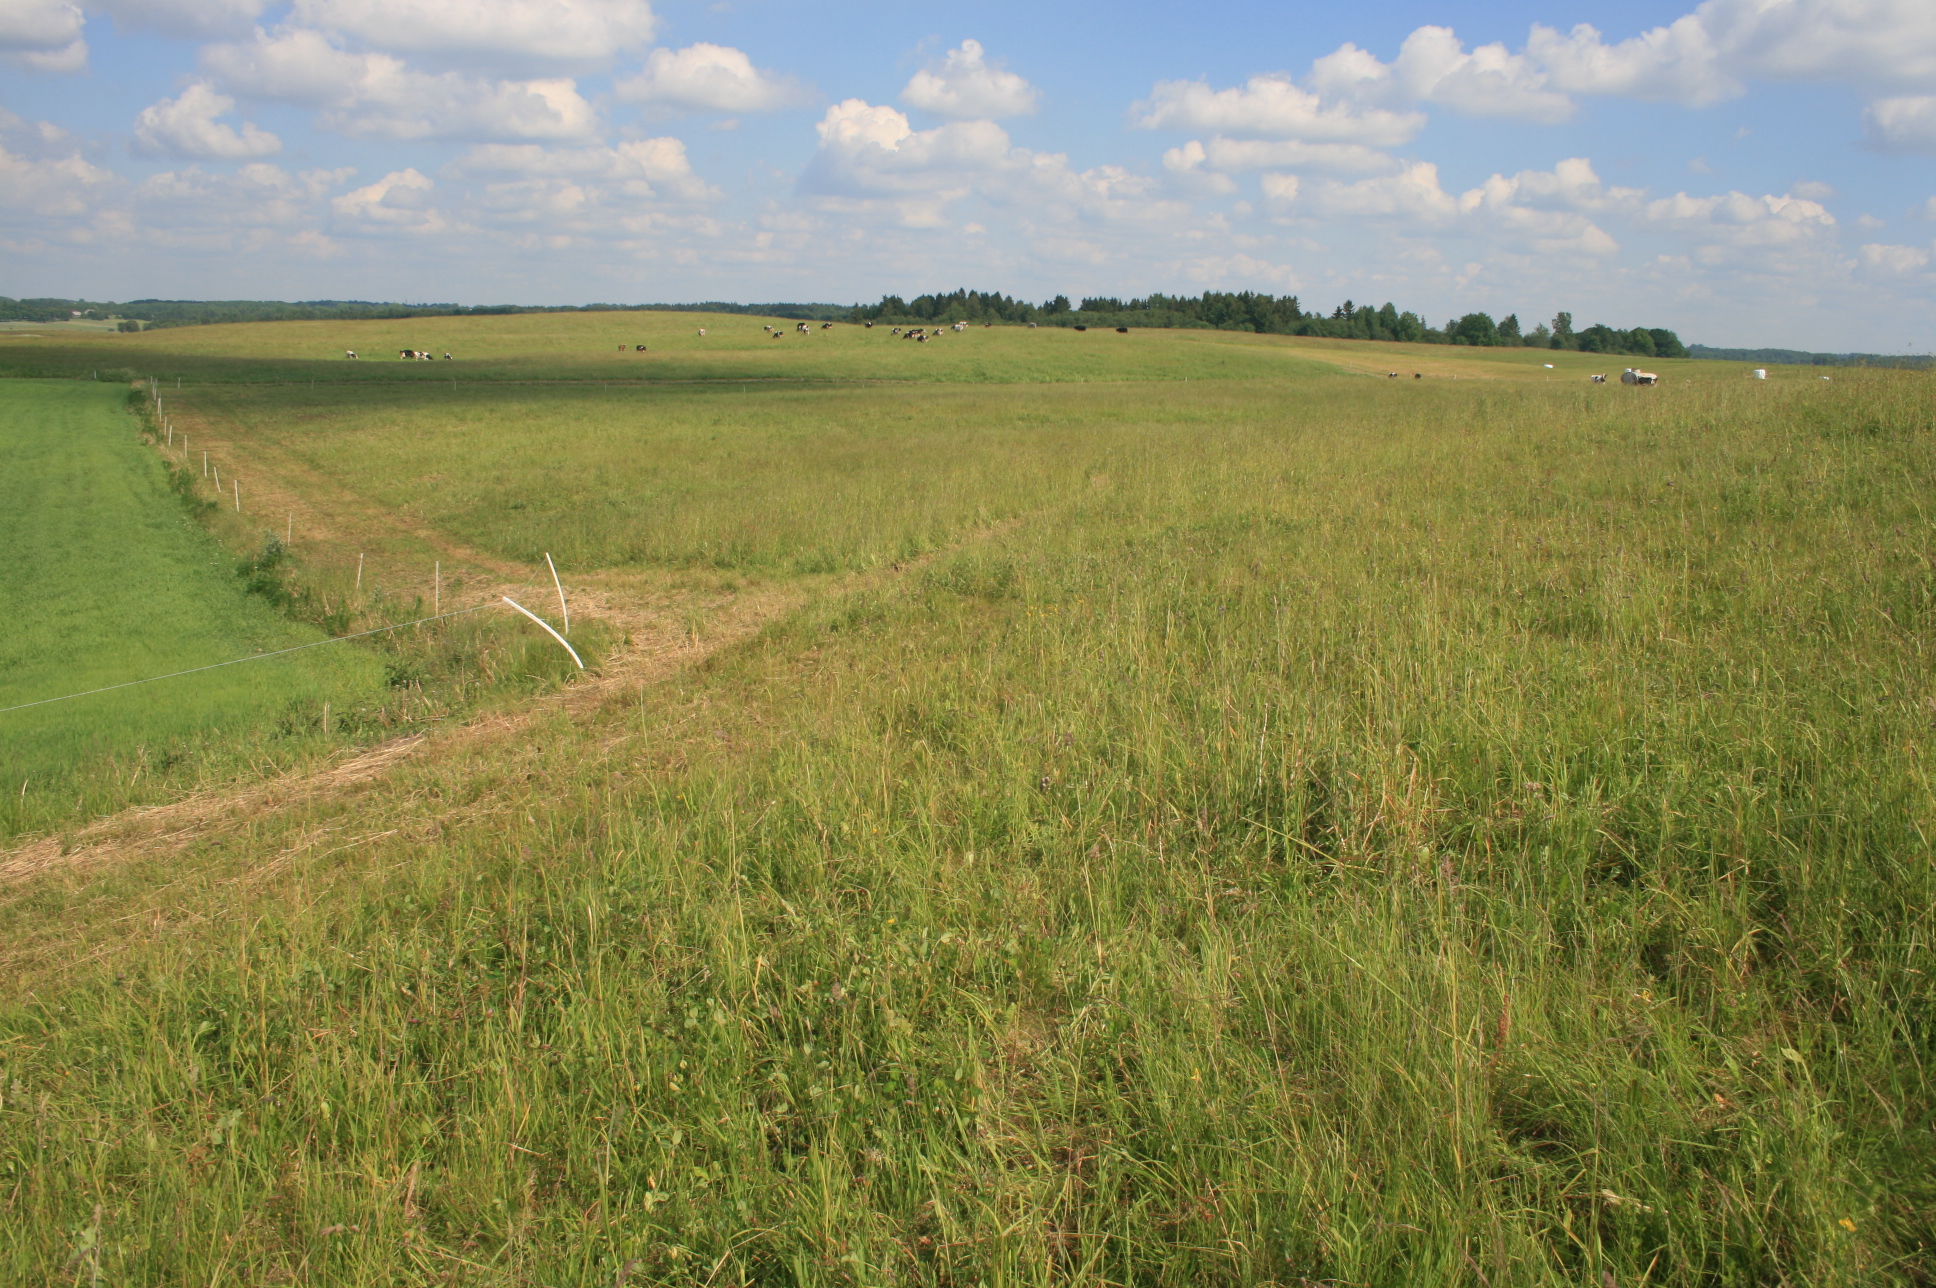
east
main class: Grassland
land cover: Grassland without tree/shrub cover
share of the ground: > 75 %
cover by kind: herbaceous plants 100 %
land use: Agriculture (excluding fallow land and kitchen gardens)
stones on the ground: < 10 %
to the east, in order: Grassland without tree/shrub cover
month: June
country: LT
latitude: 55.6239
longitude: 22.1722
